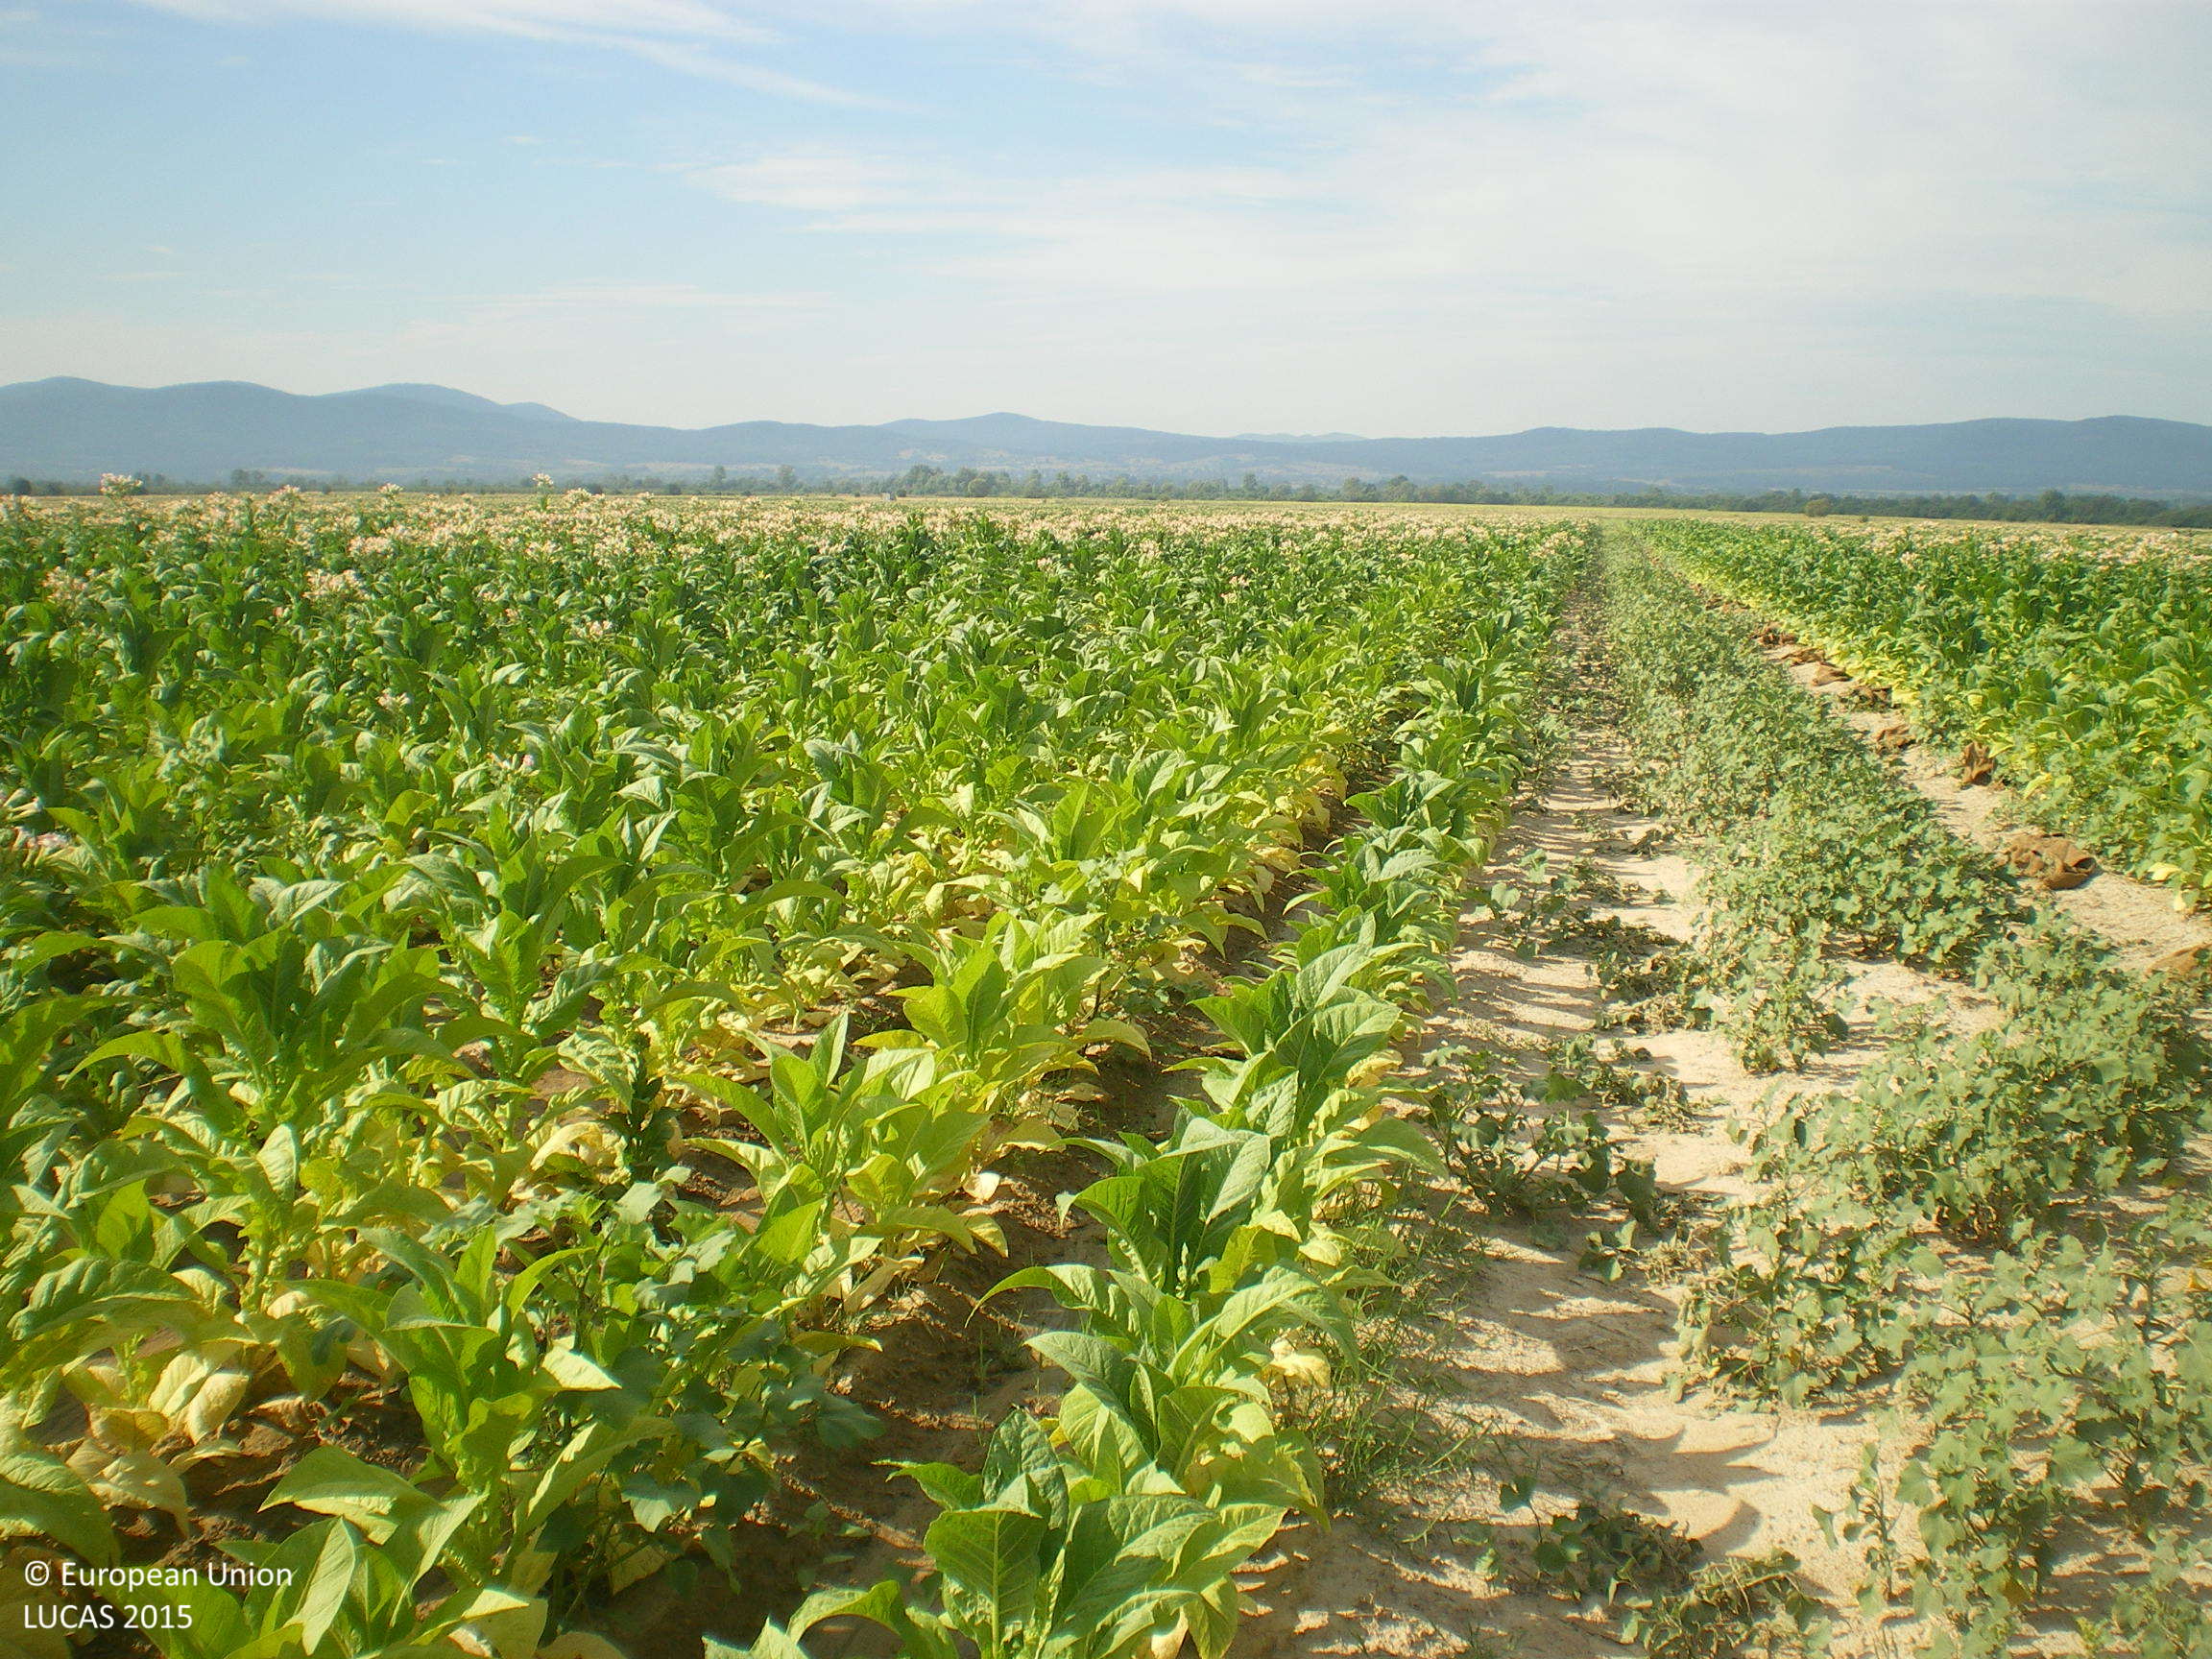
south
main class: Cropland
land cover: Tobacco
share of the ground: > 75 %
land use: Agriculture (excluding fallow land and kitchen gardens)
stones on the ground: < 10 %
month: August
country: BG
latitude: 42.5887
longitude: 25.5108
